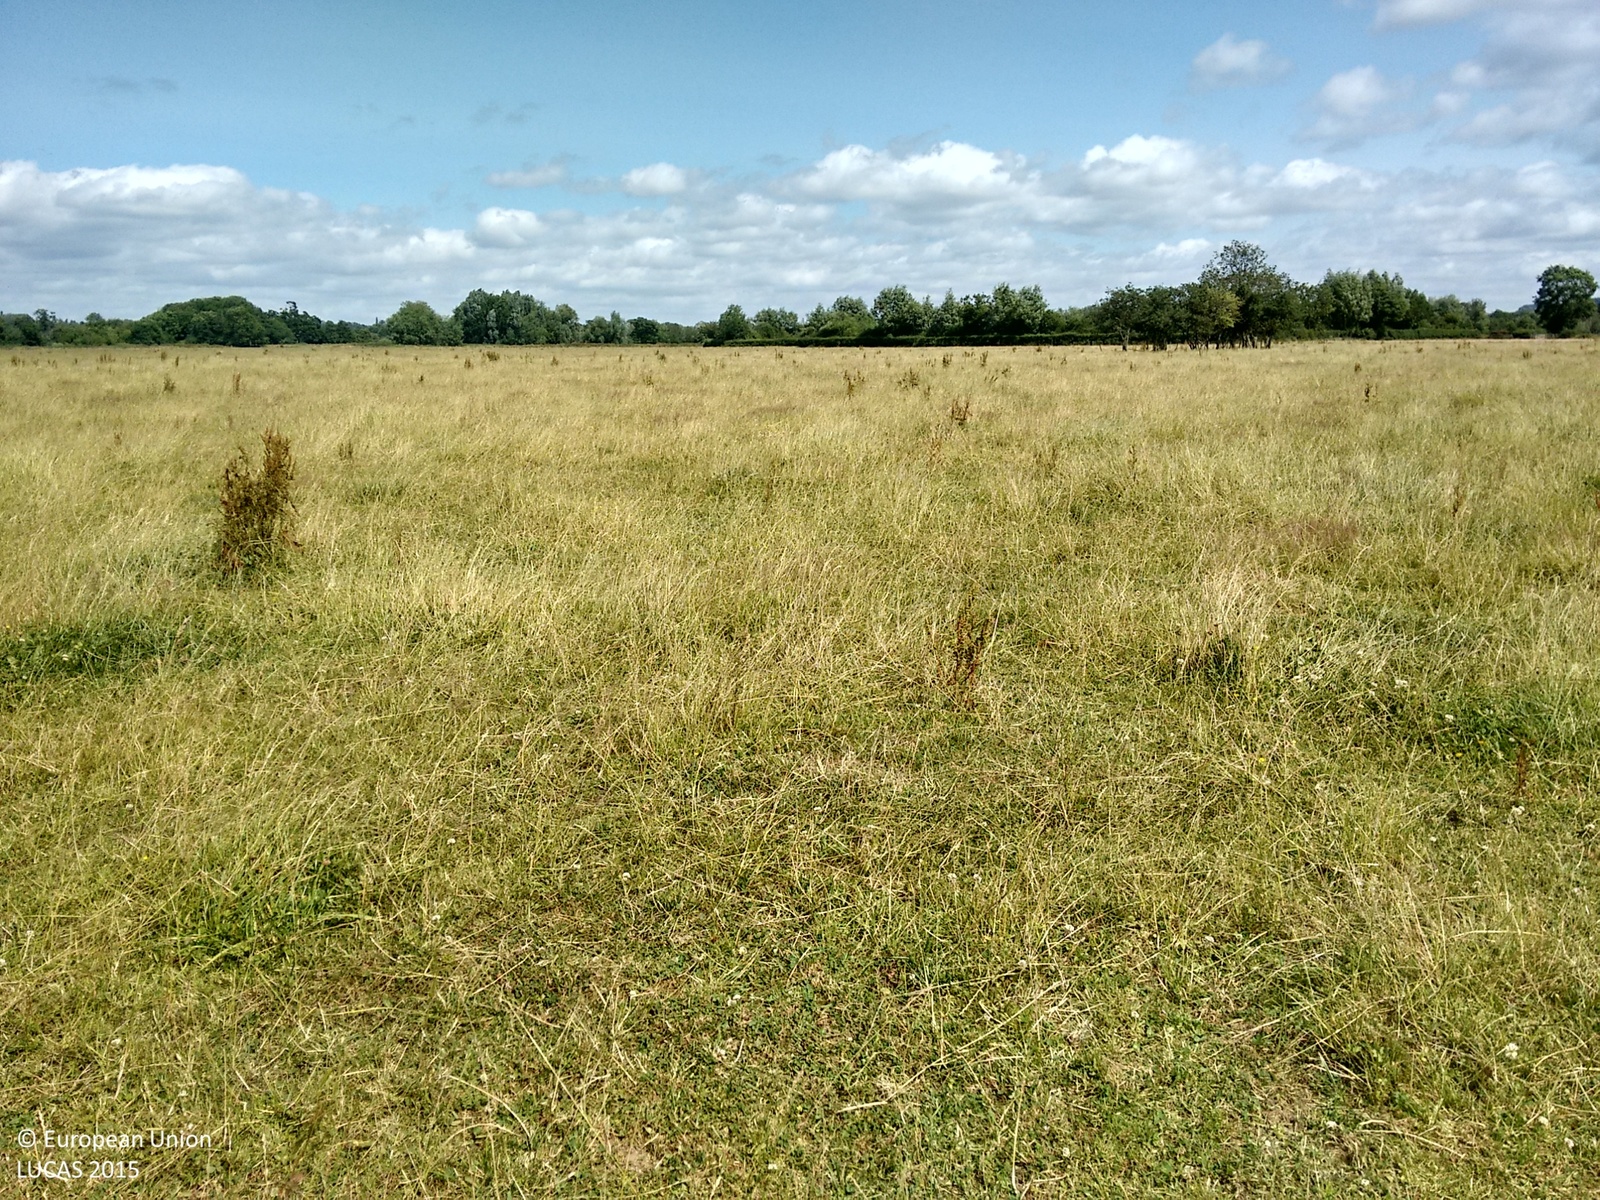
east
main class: Grassland
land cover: Grassland without tree/shrub cover
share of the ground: > 75 %
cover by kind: herbaceous plants 100 %
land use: Agriculture (excluding fallow land and kitchen gardens)
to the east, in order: Grassland without tree/shrub cover; Fences; Managed hedges; Ditches and canals; Lines of trees; Fences; Grassland without tree/shrub cover
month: July
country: GB
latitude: 52.2103
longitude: -2.7888
